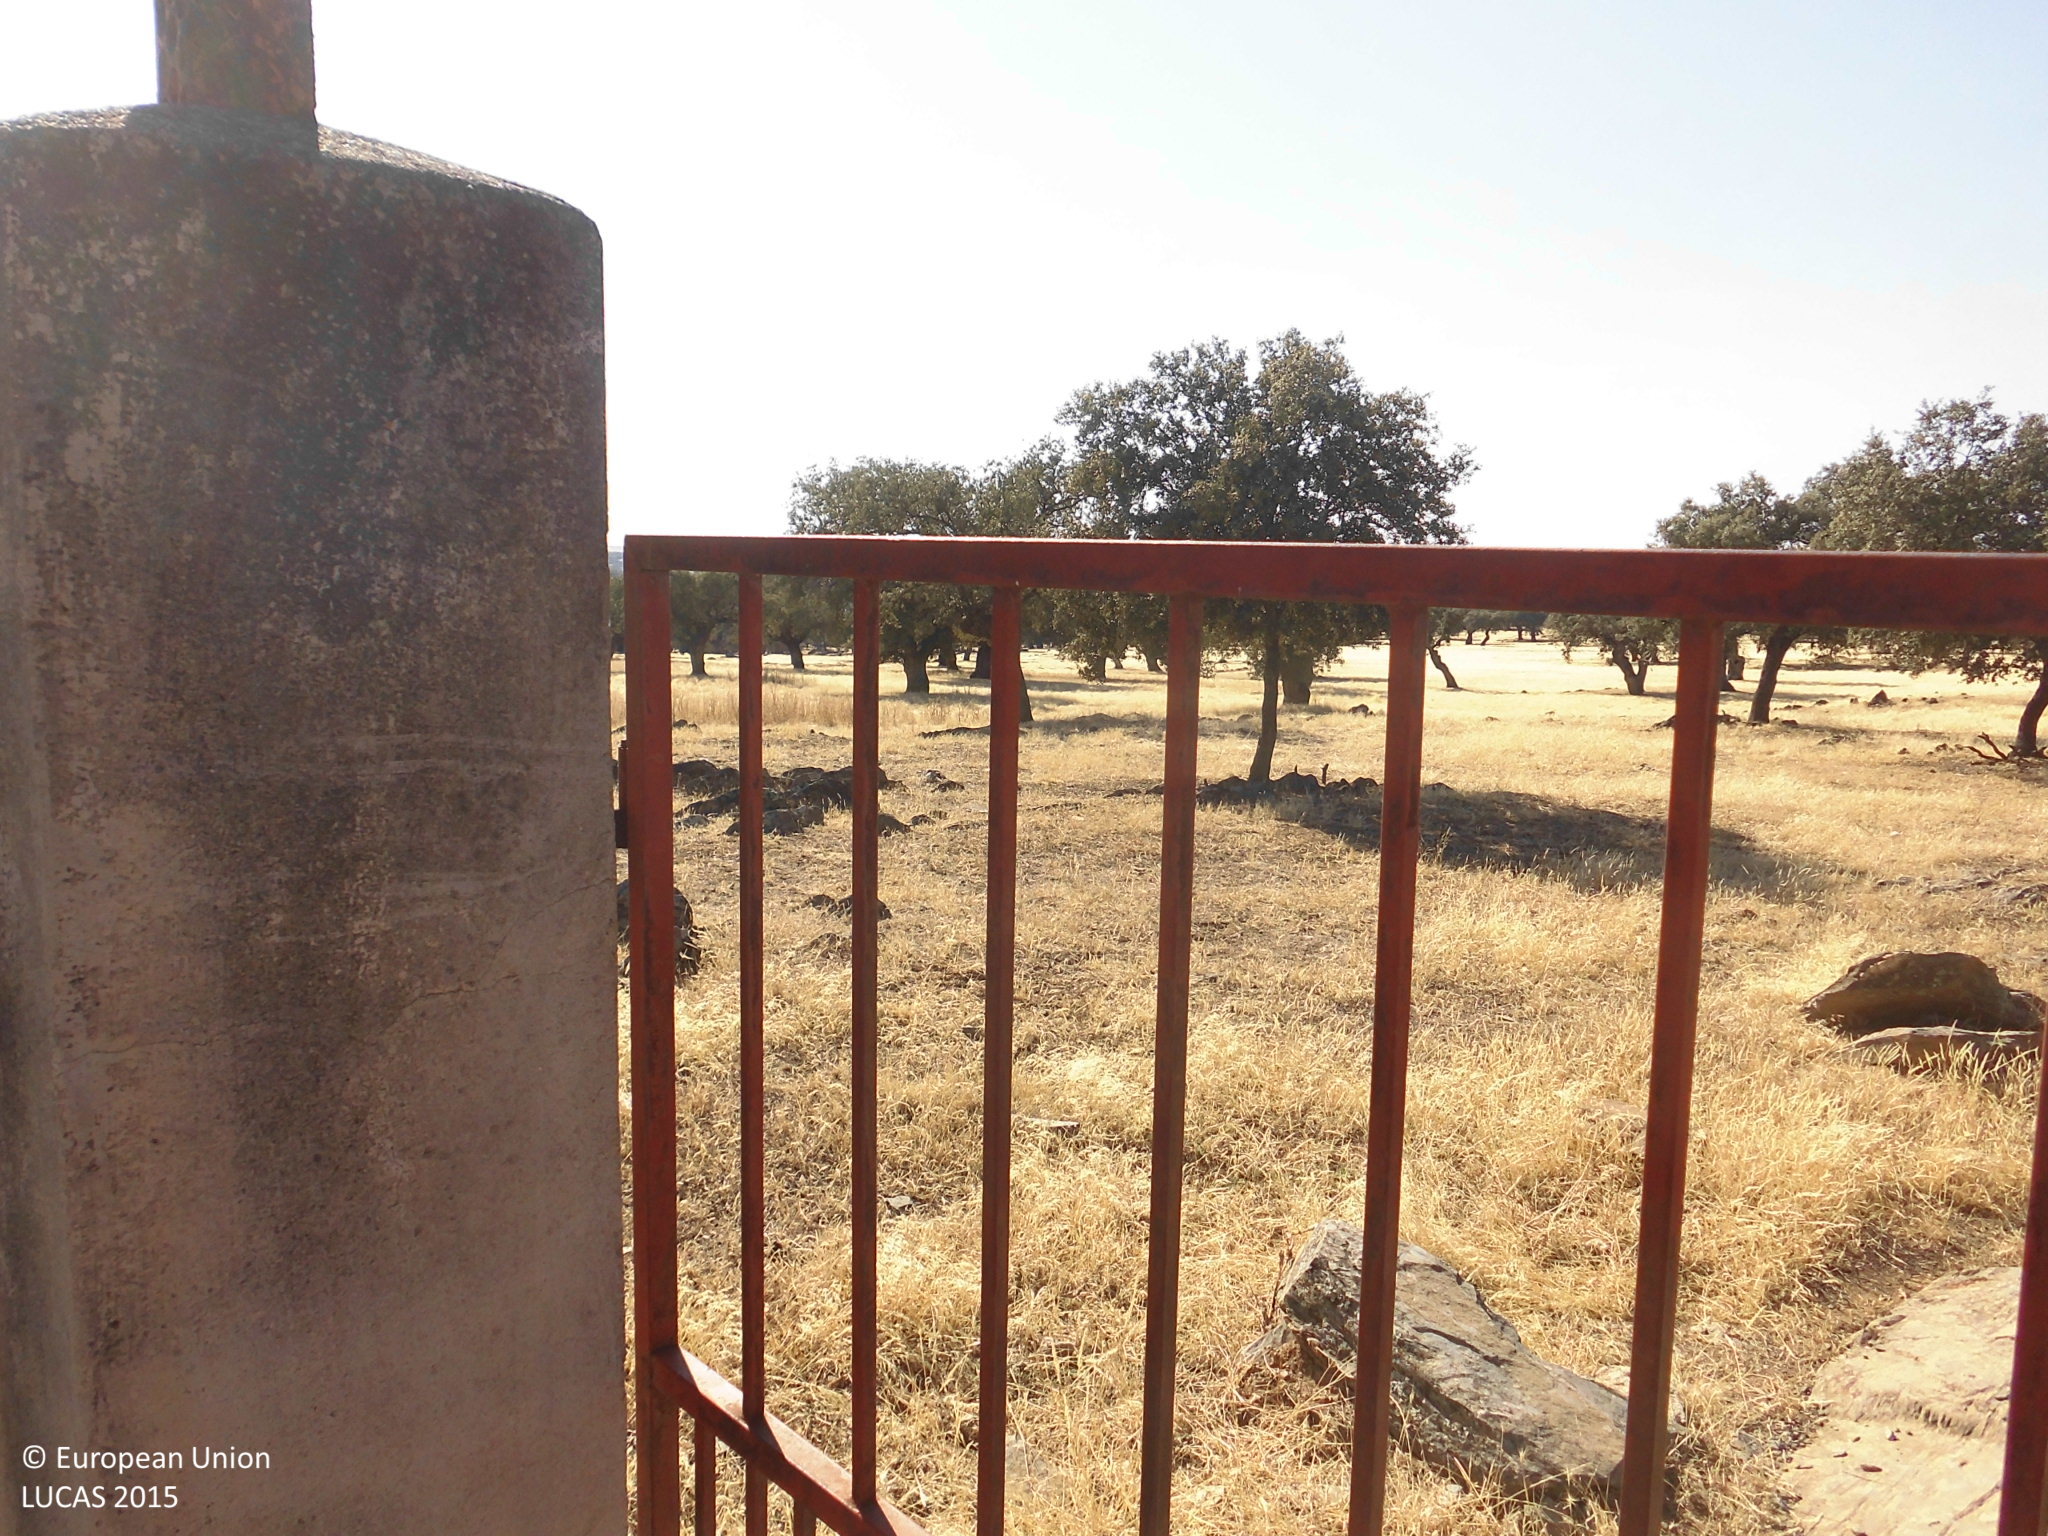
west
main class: Woodland
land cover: Broadleaved woodland
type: broadleaved evergreen forest
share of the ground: 10 - 25 %
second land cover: Grassland without tree/shrub cover
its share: > 75 %
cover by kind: herbaceous plants 80 %, broadleaved forest trees 20 %
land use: Forestry
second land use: Agriculture (excluding fallow land and kitchen gardens)
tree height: > 5 m
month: July
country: ES
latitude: 39.5636
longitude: -5.5934
